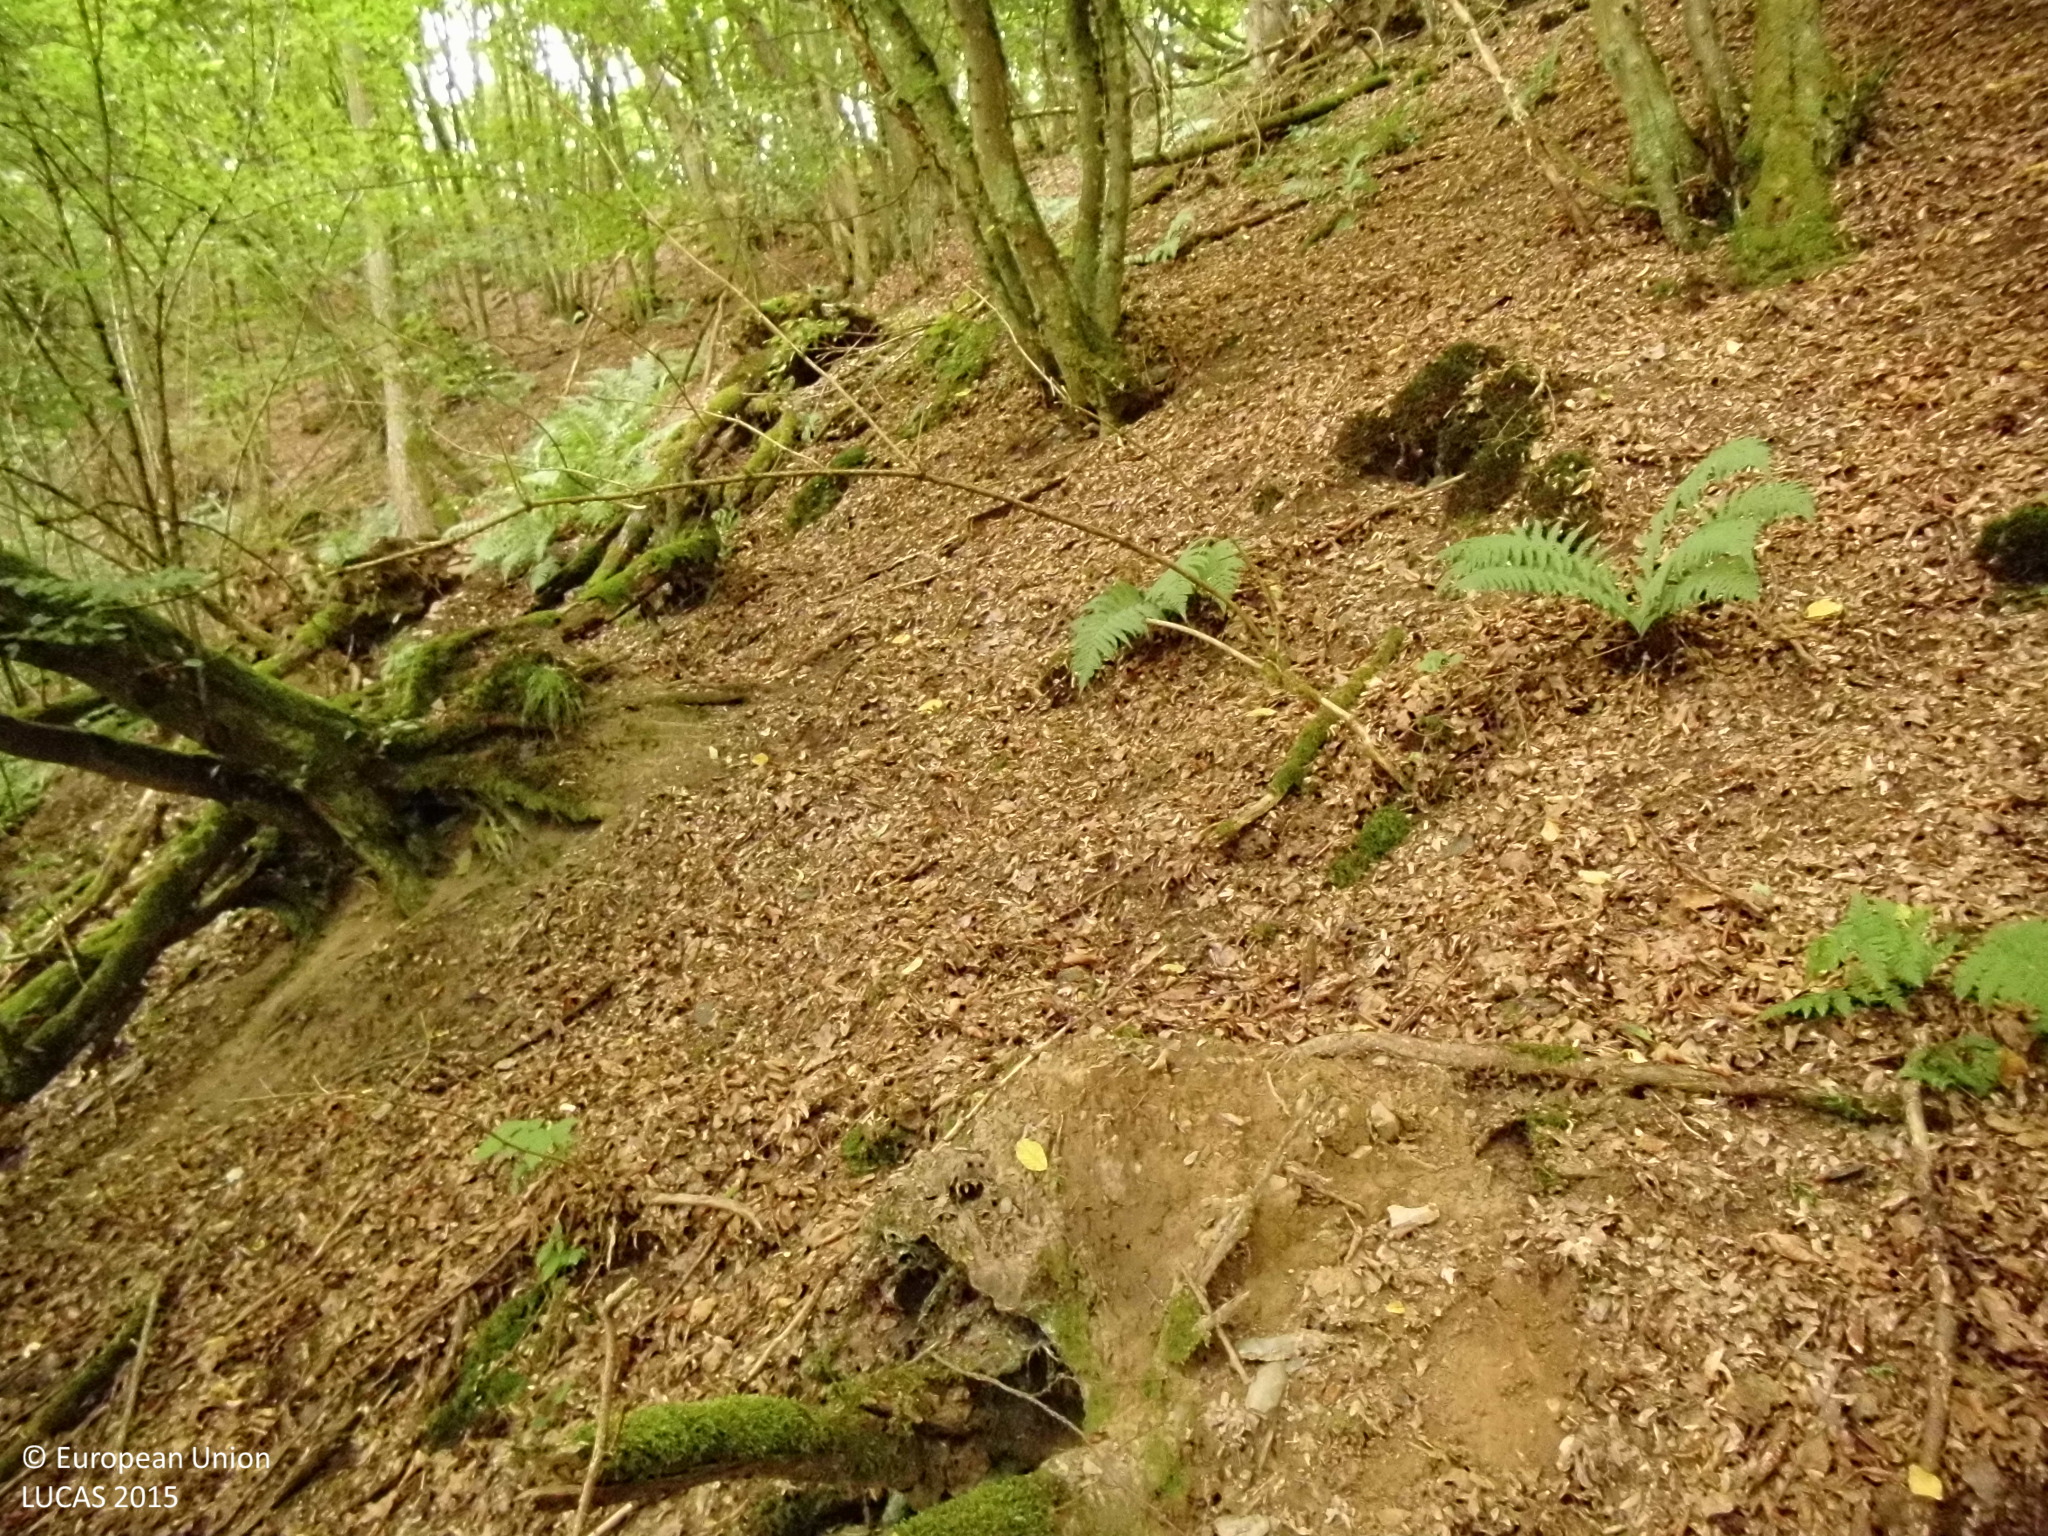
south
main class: Woodland
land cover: Broadleaved woodland
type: mesophytic deciduous forest
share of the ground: > 75 %
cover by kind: broadleaved forest trees 100 %
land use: Forestry
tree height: > 5 m
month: August
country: DE
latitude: 51.0207
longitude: 8.5890
